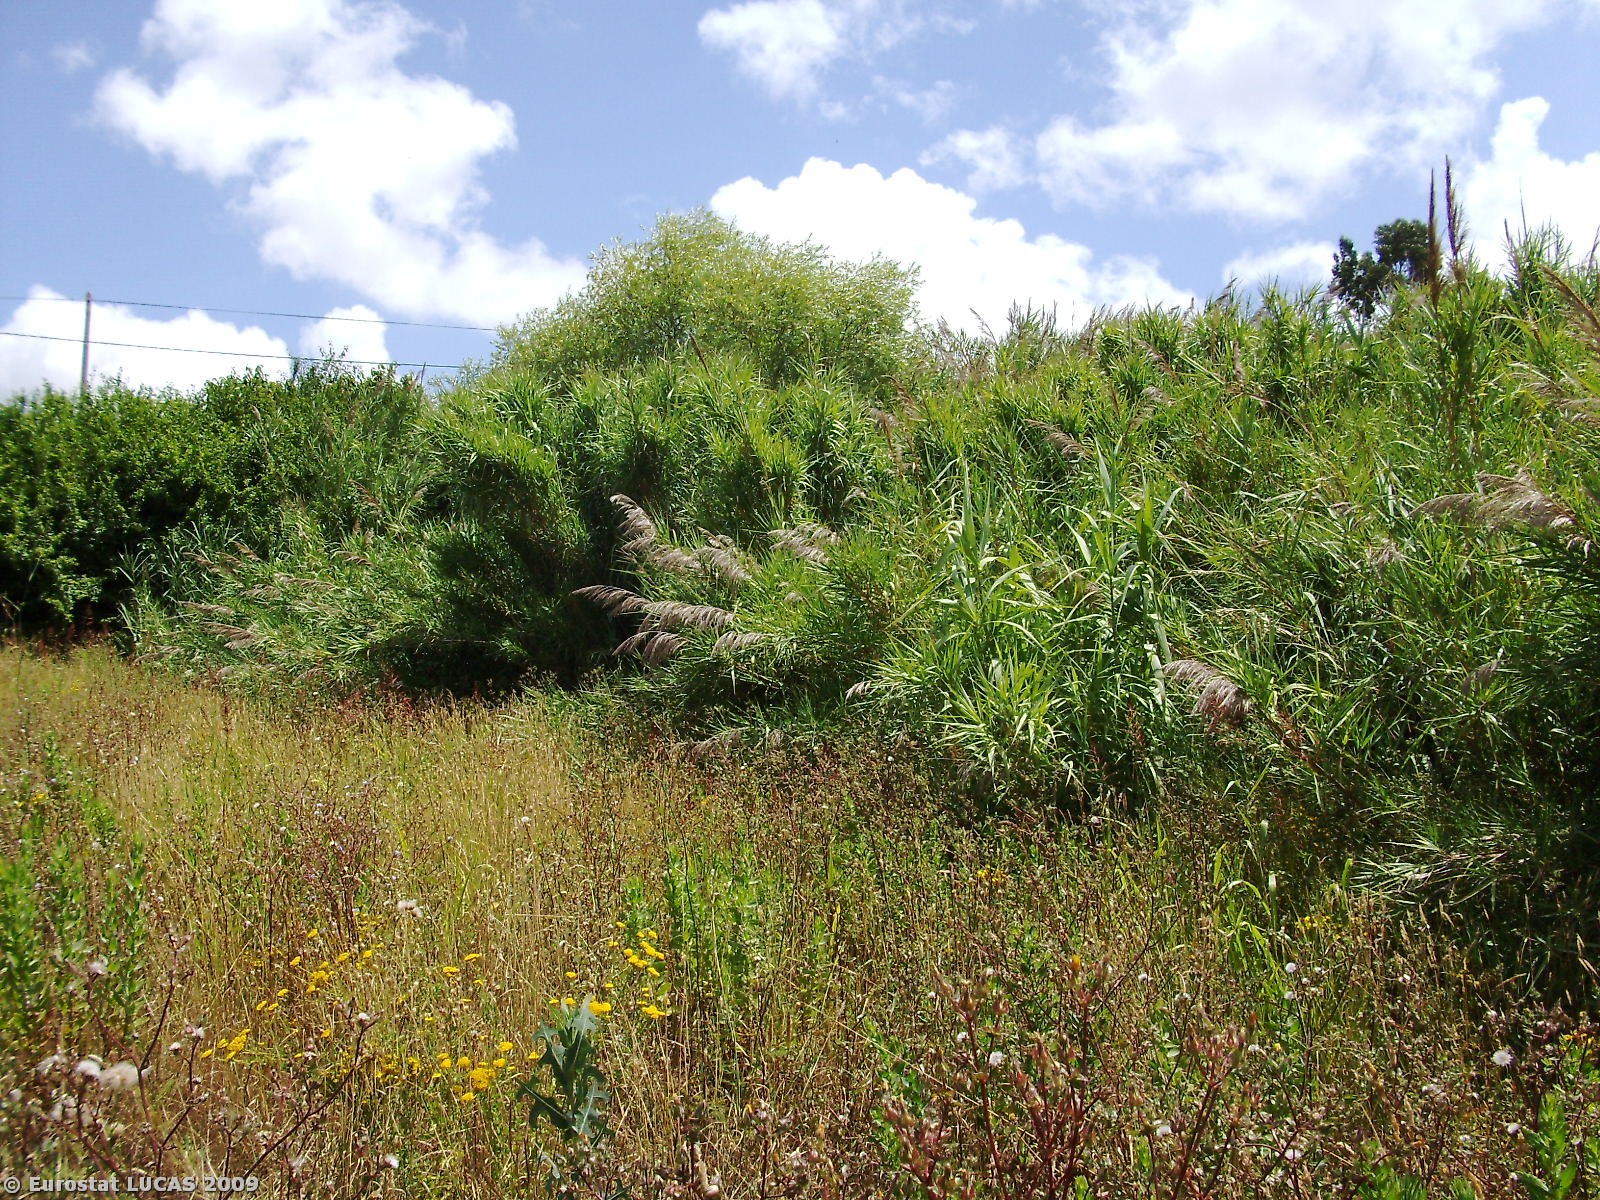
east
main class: Grassland
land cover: Spontaneously vegetated surfaces
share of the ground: > 75 %
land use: Fallow land
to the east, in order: Spontaneously vegetated surfaces; Shrubland with sparse tree cover; Paved roads, cycling and walking lanes; Electric lines; Fences; Vineyards; Dry stone walls; Shruby margins; Arable land (only in case pi); Artificial constructions in urban areas
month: July
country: PT
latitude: 39.4702
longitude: -9.0702
